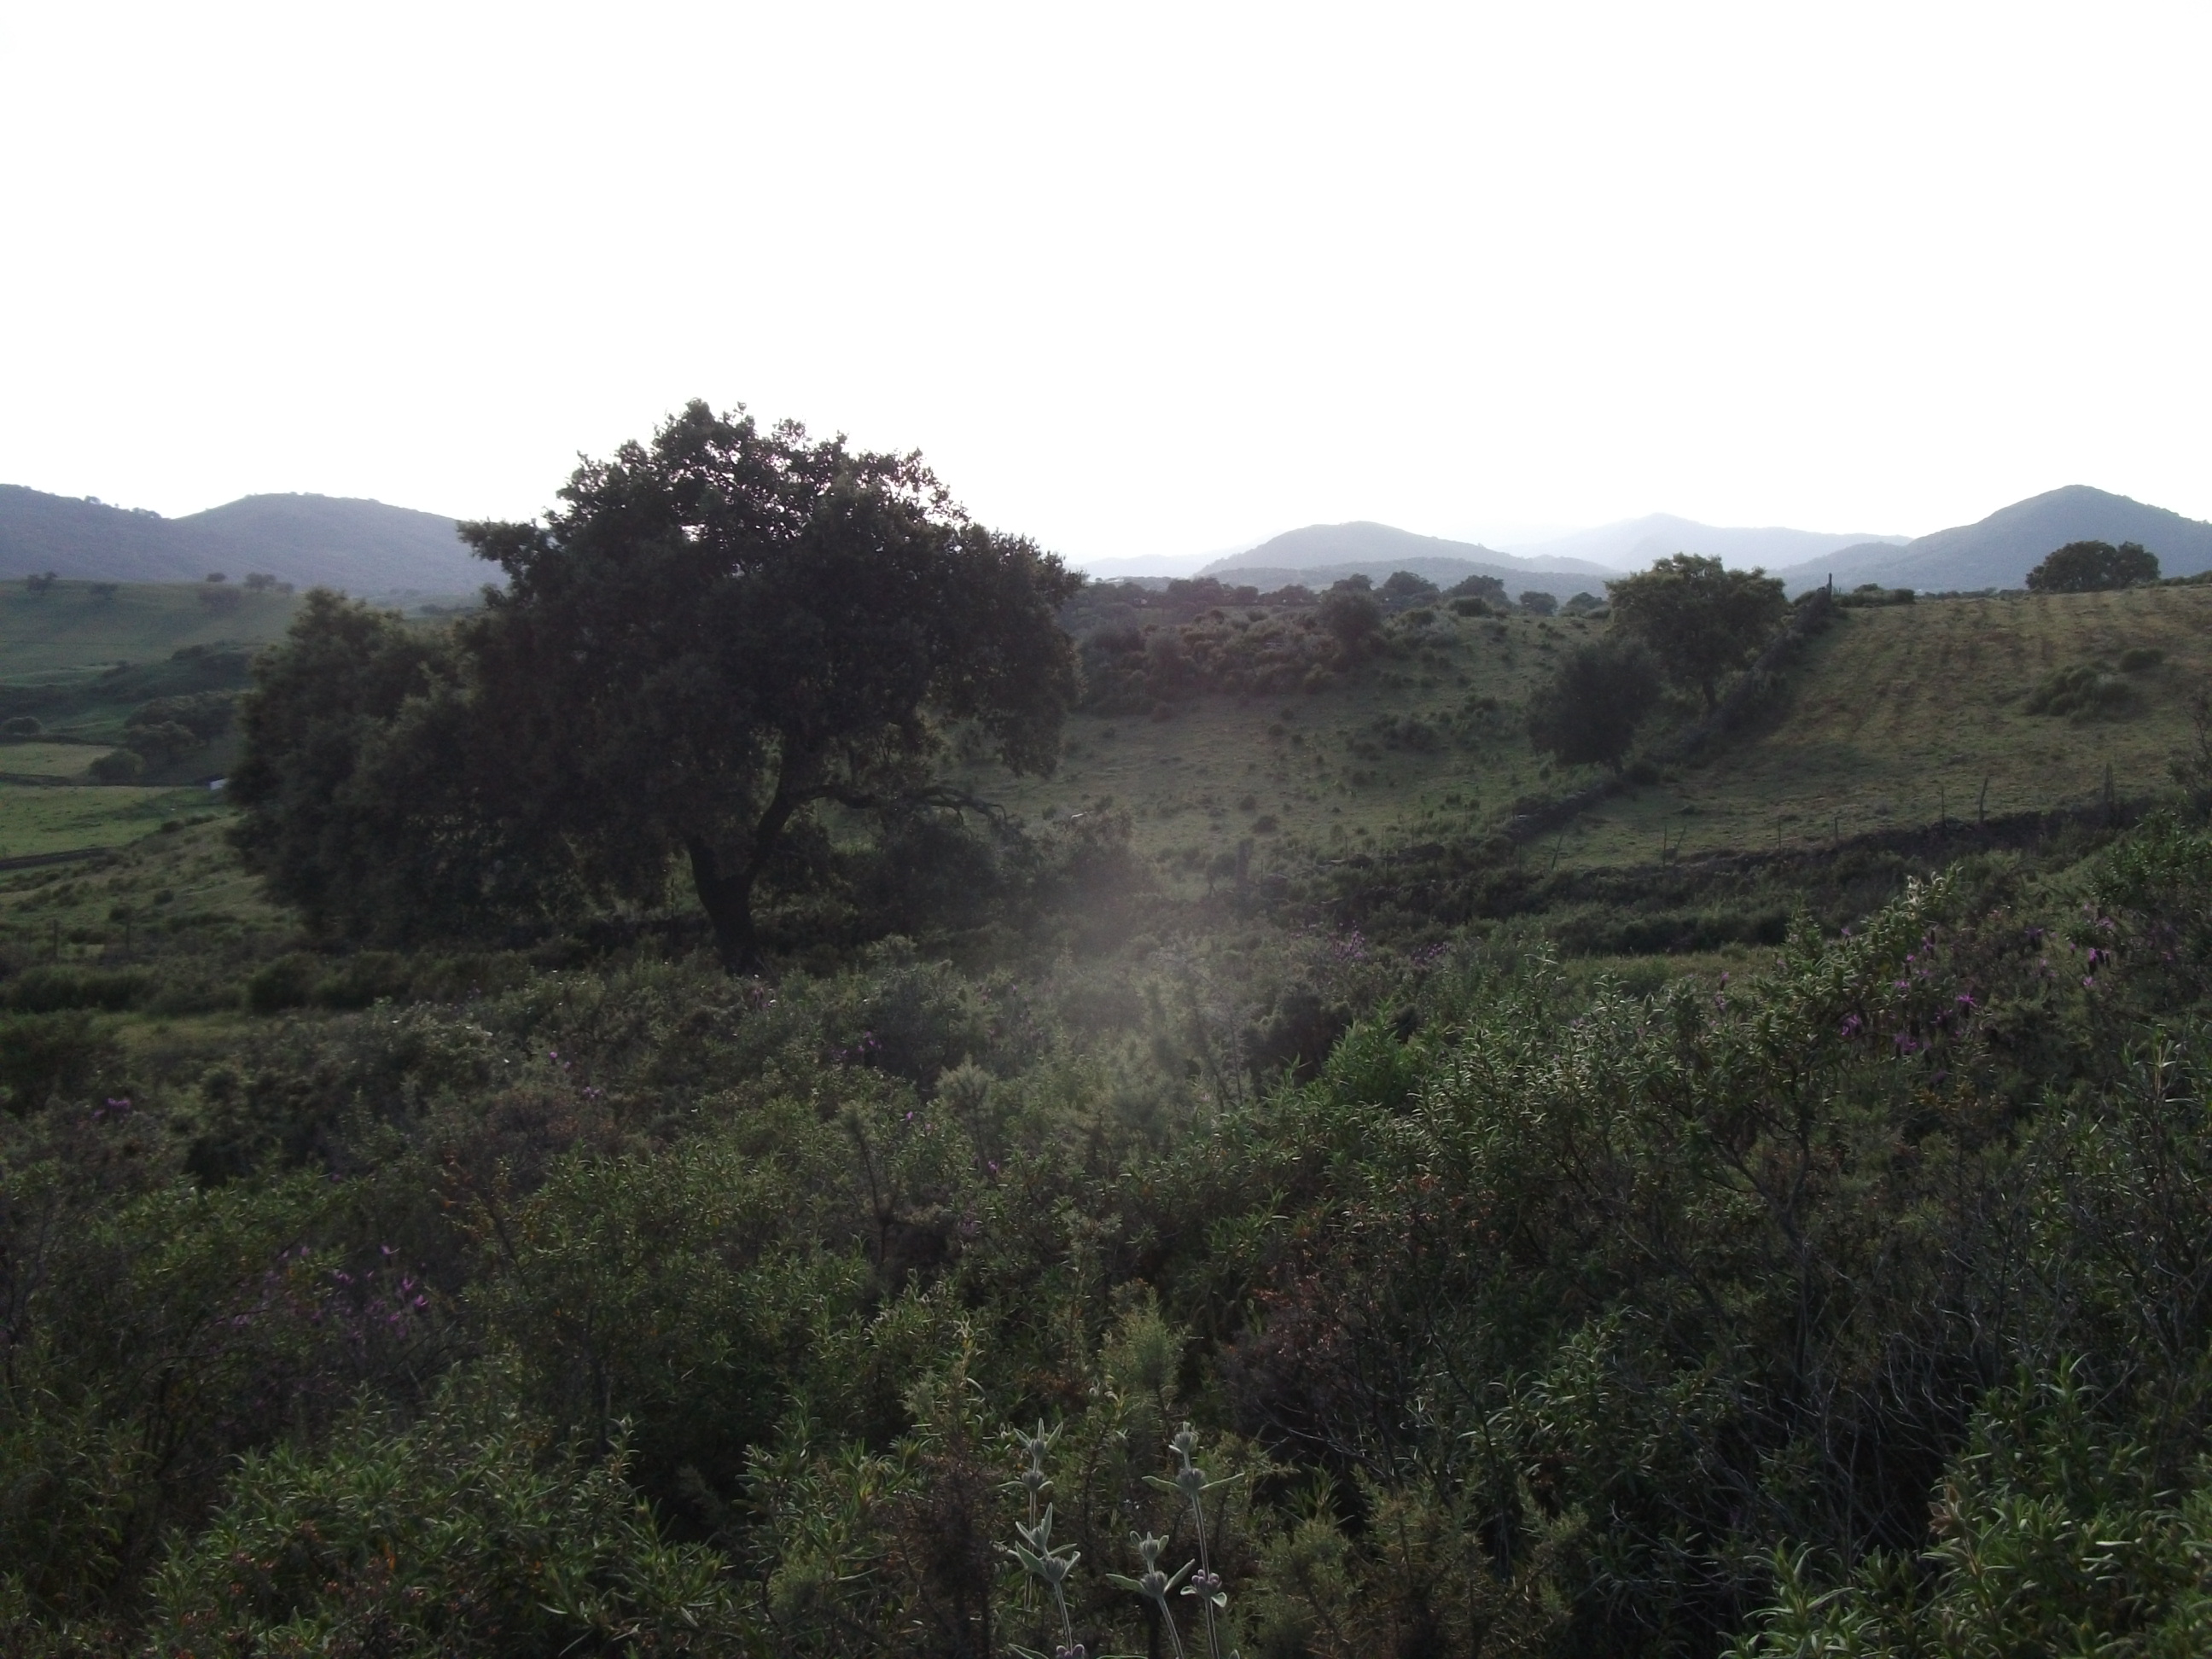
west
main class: Woodland
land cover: Broadleaved woodland
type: broadleaved evergreen forest
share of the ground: 10 - 25 %
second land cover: Shrubland without tree cover
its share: > 75 %
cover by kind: shrubs 90 %, broadleaved forest trees 10 %
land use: Forestry
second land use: Agriculture (excluding fallow land and kitchen gardens)
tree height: > 5 m
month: April
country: ES
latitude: 37.8756
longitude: -6.5386
